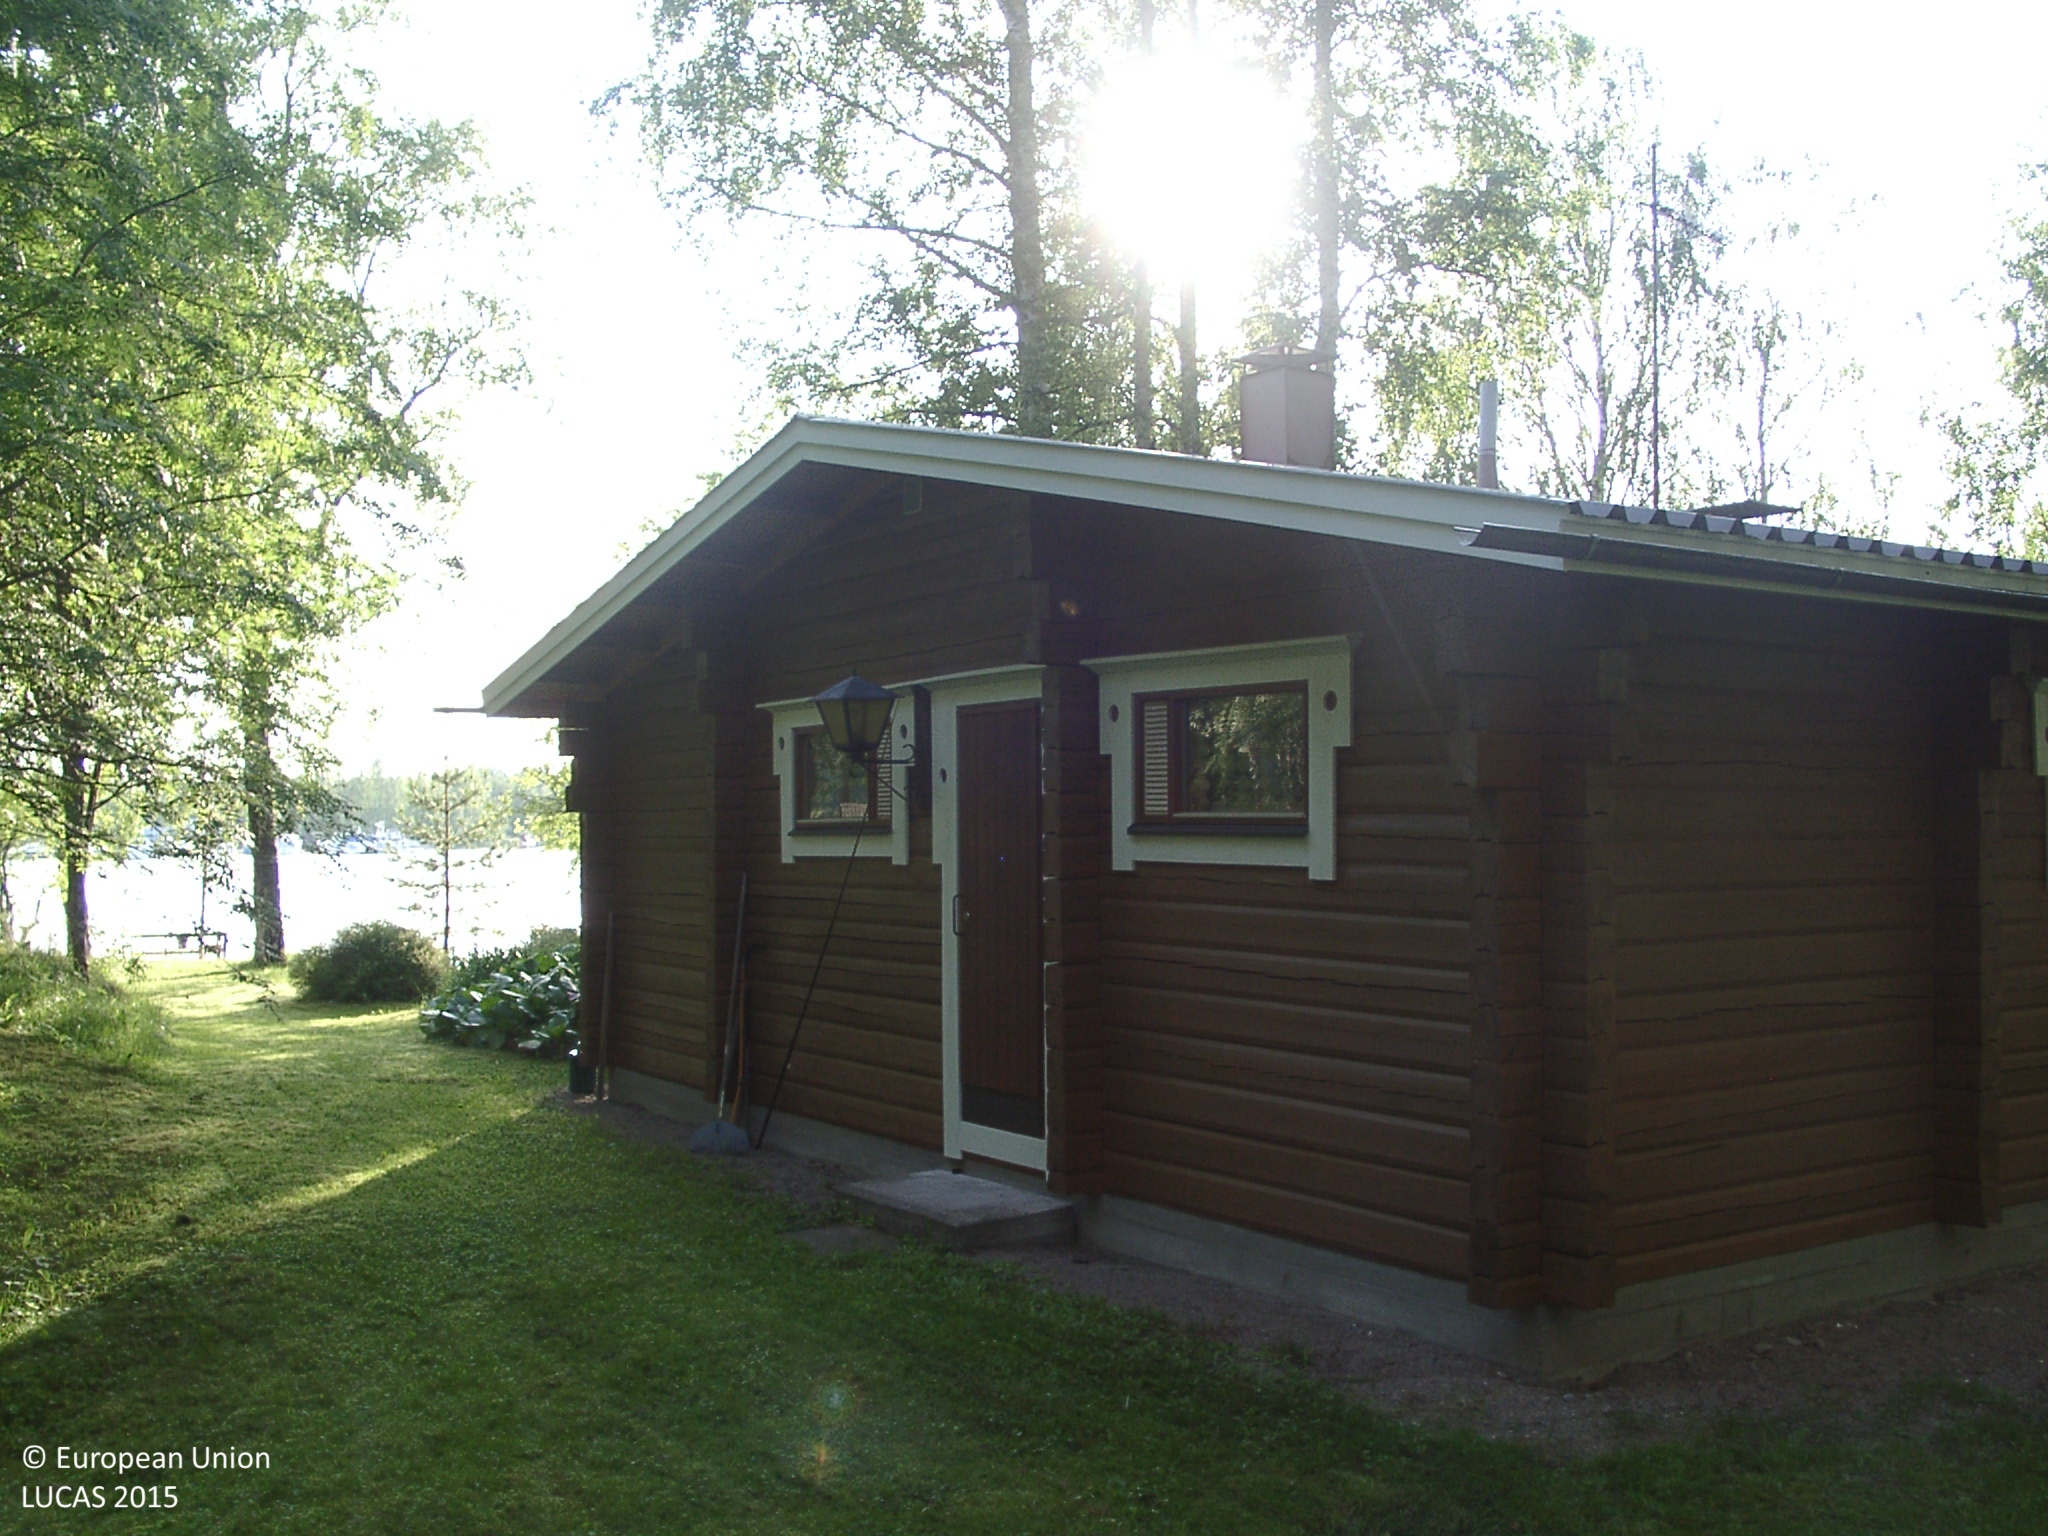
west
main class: Woodland
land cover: Broadleaved woodland
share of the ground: > 75 %
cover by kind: broadleaved forest trees 70 %, herbaceous plants 25 %, coniferous forest trees 5 %
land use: Residential
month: July
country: FI
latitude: 61.5587
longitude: 25.1898
